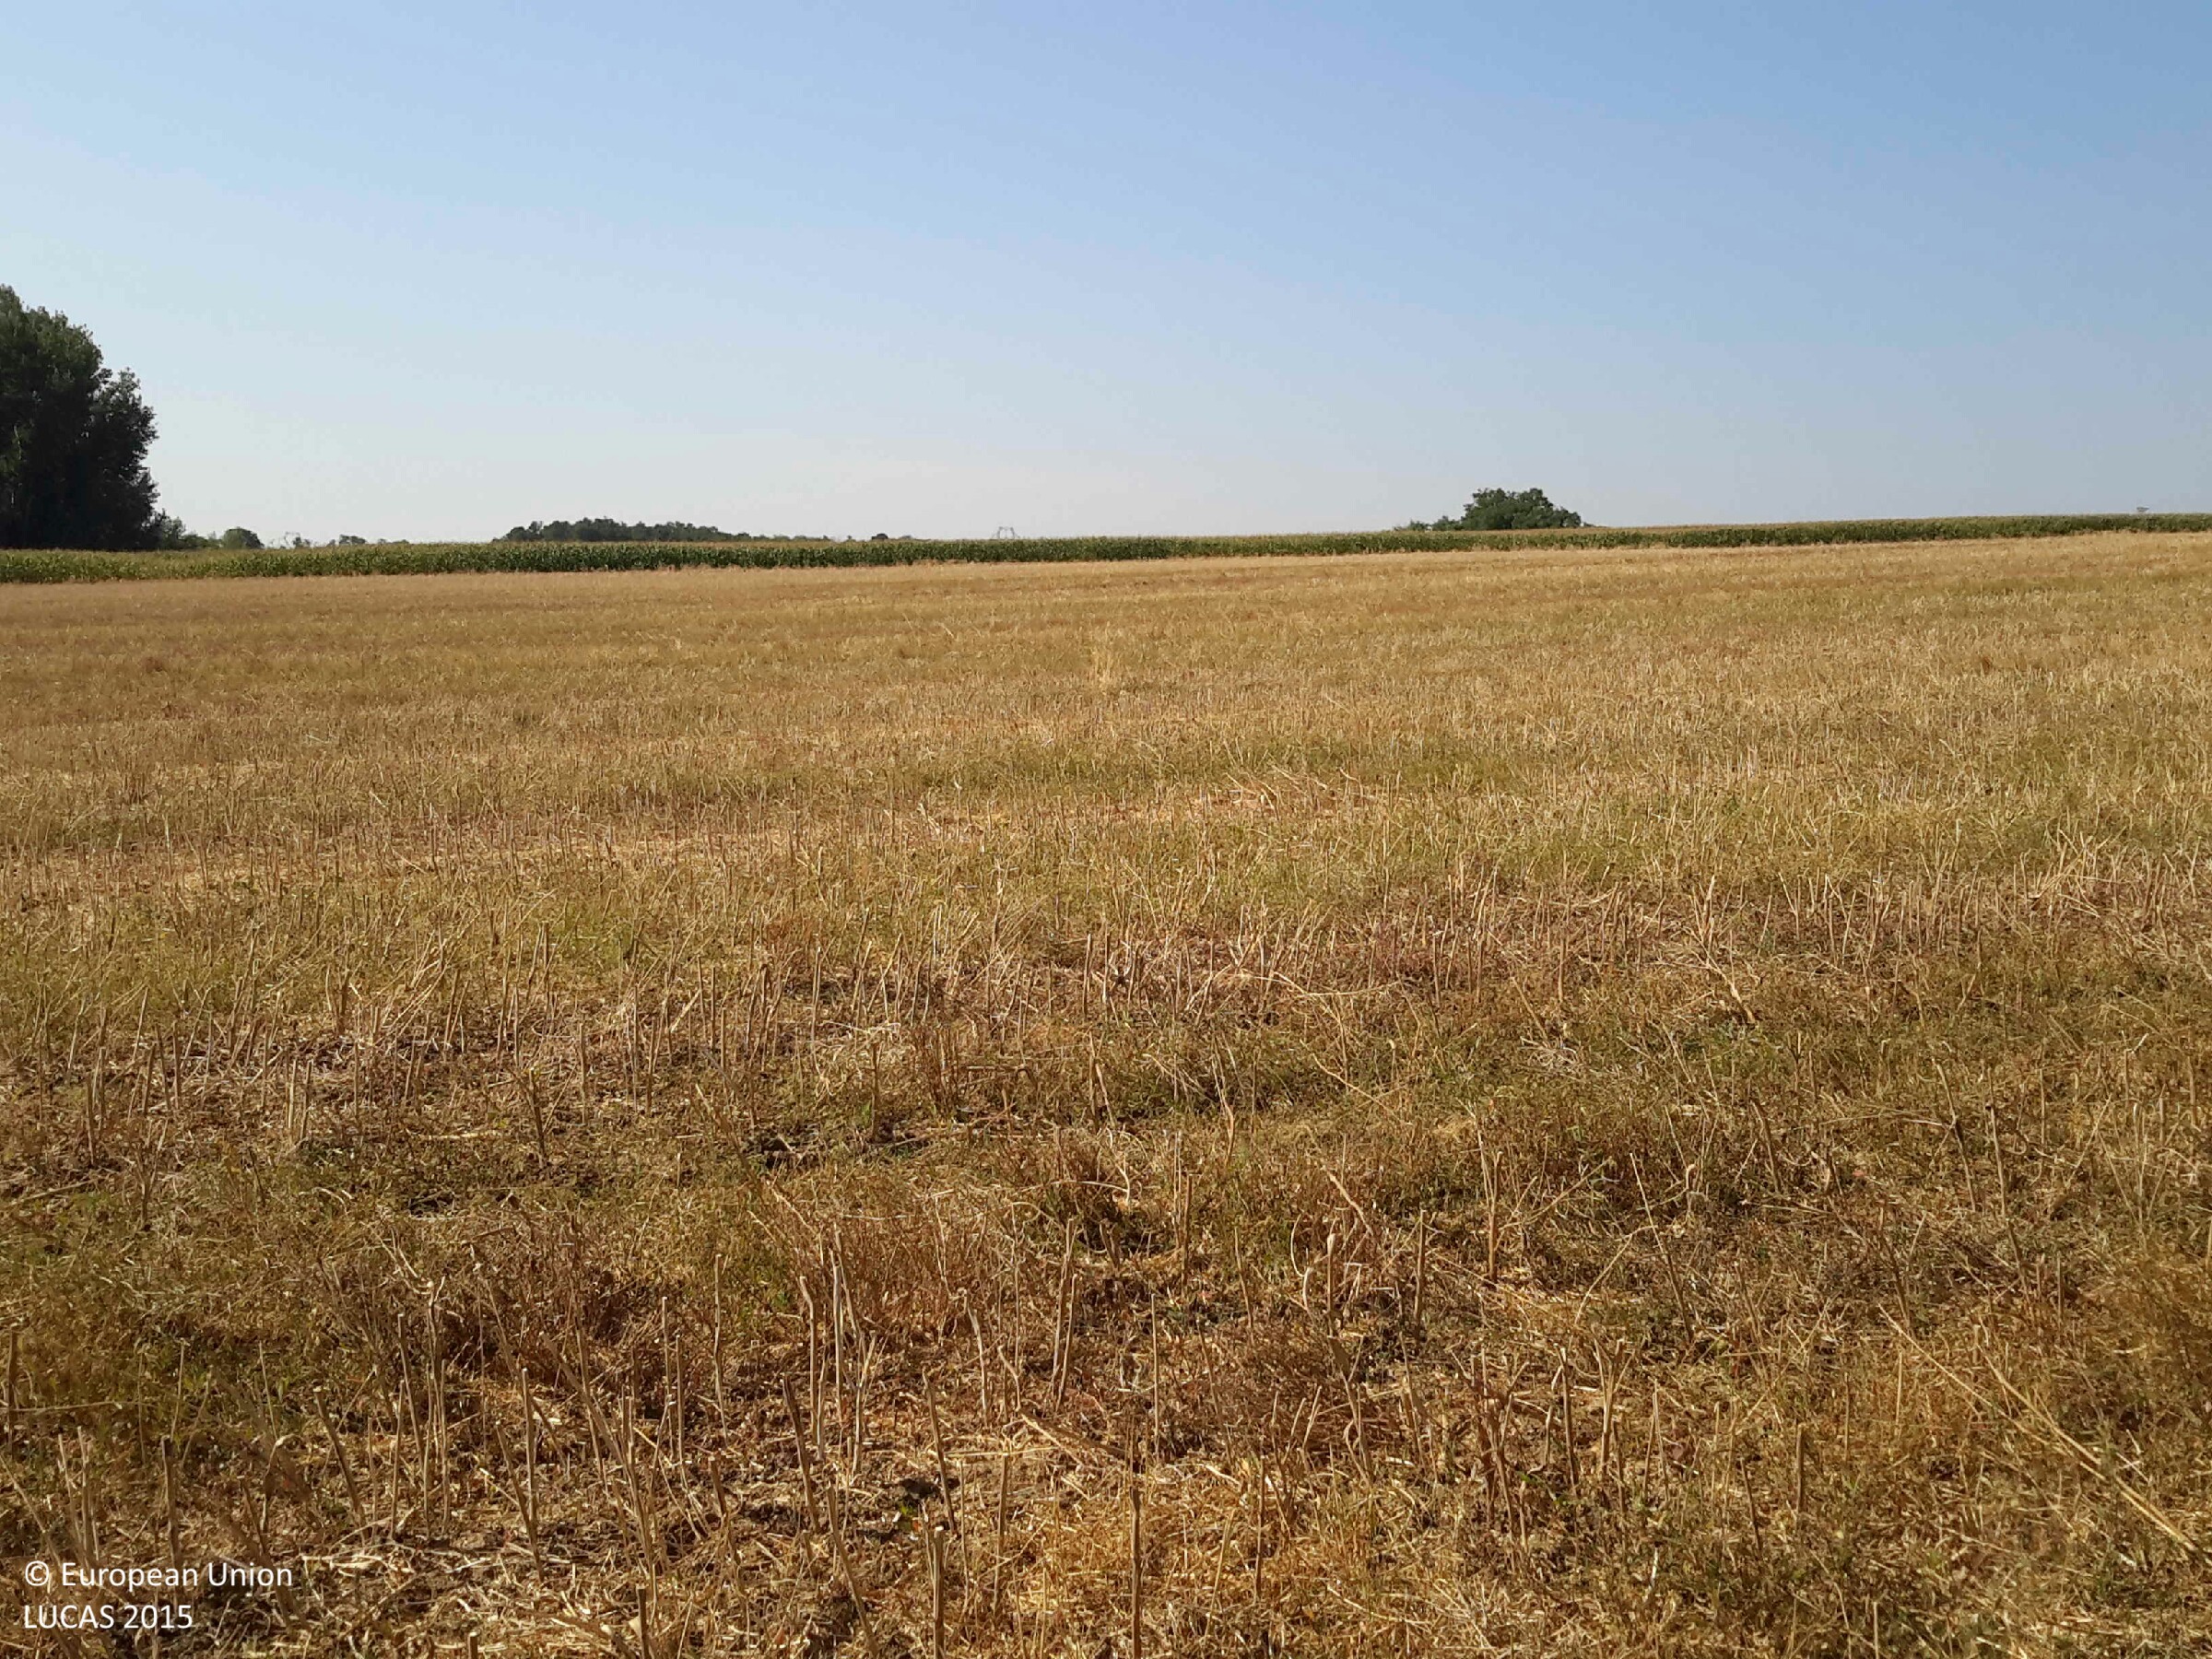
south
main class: Cropland
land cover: Rape and turnip rape
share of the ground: < 10 %
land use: Agriculture (excluding fallow land and kitchen gardens)
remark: Harvested field
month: July
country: HU
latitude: 47.4891
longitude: 17.8806
